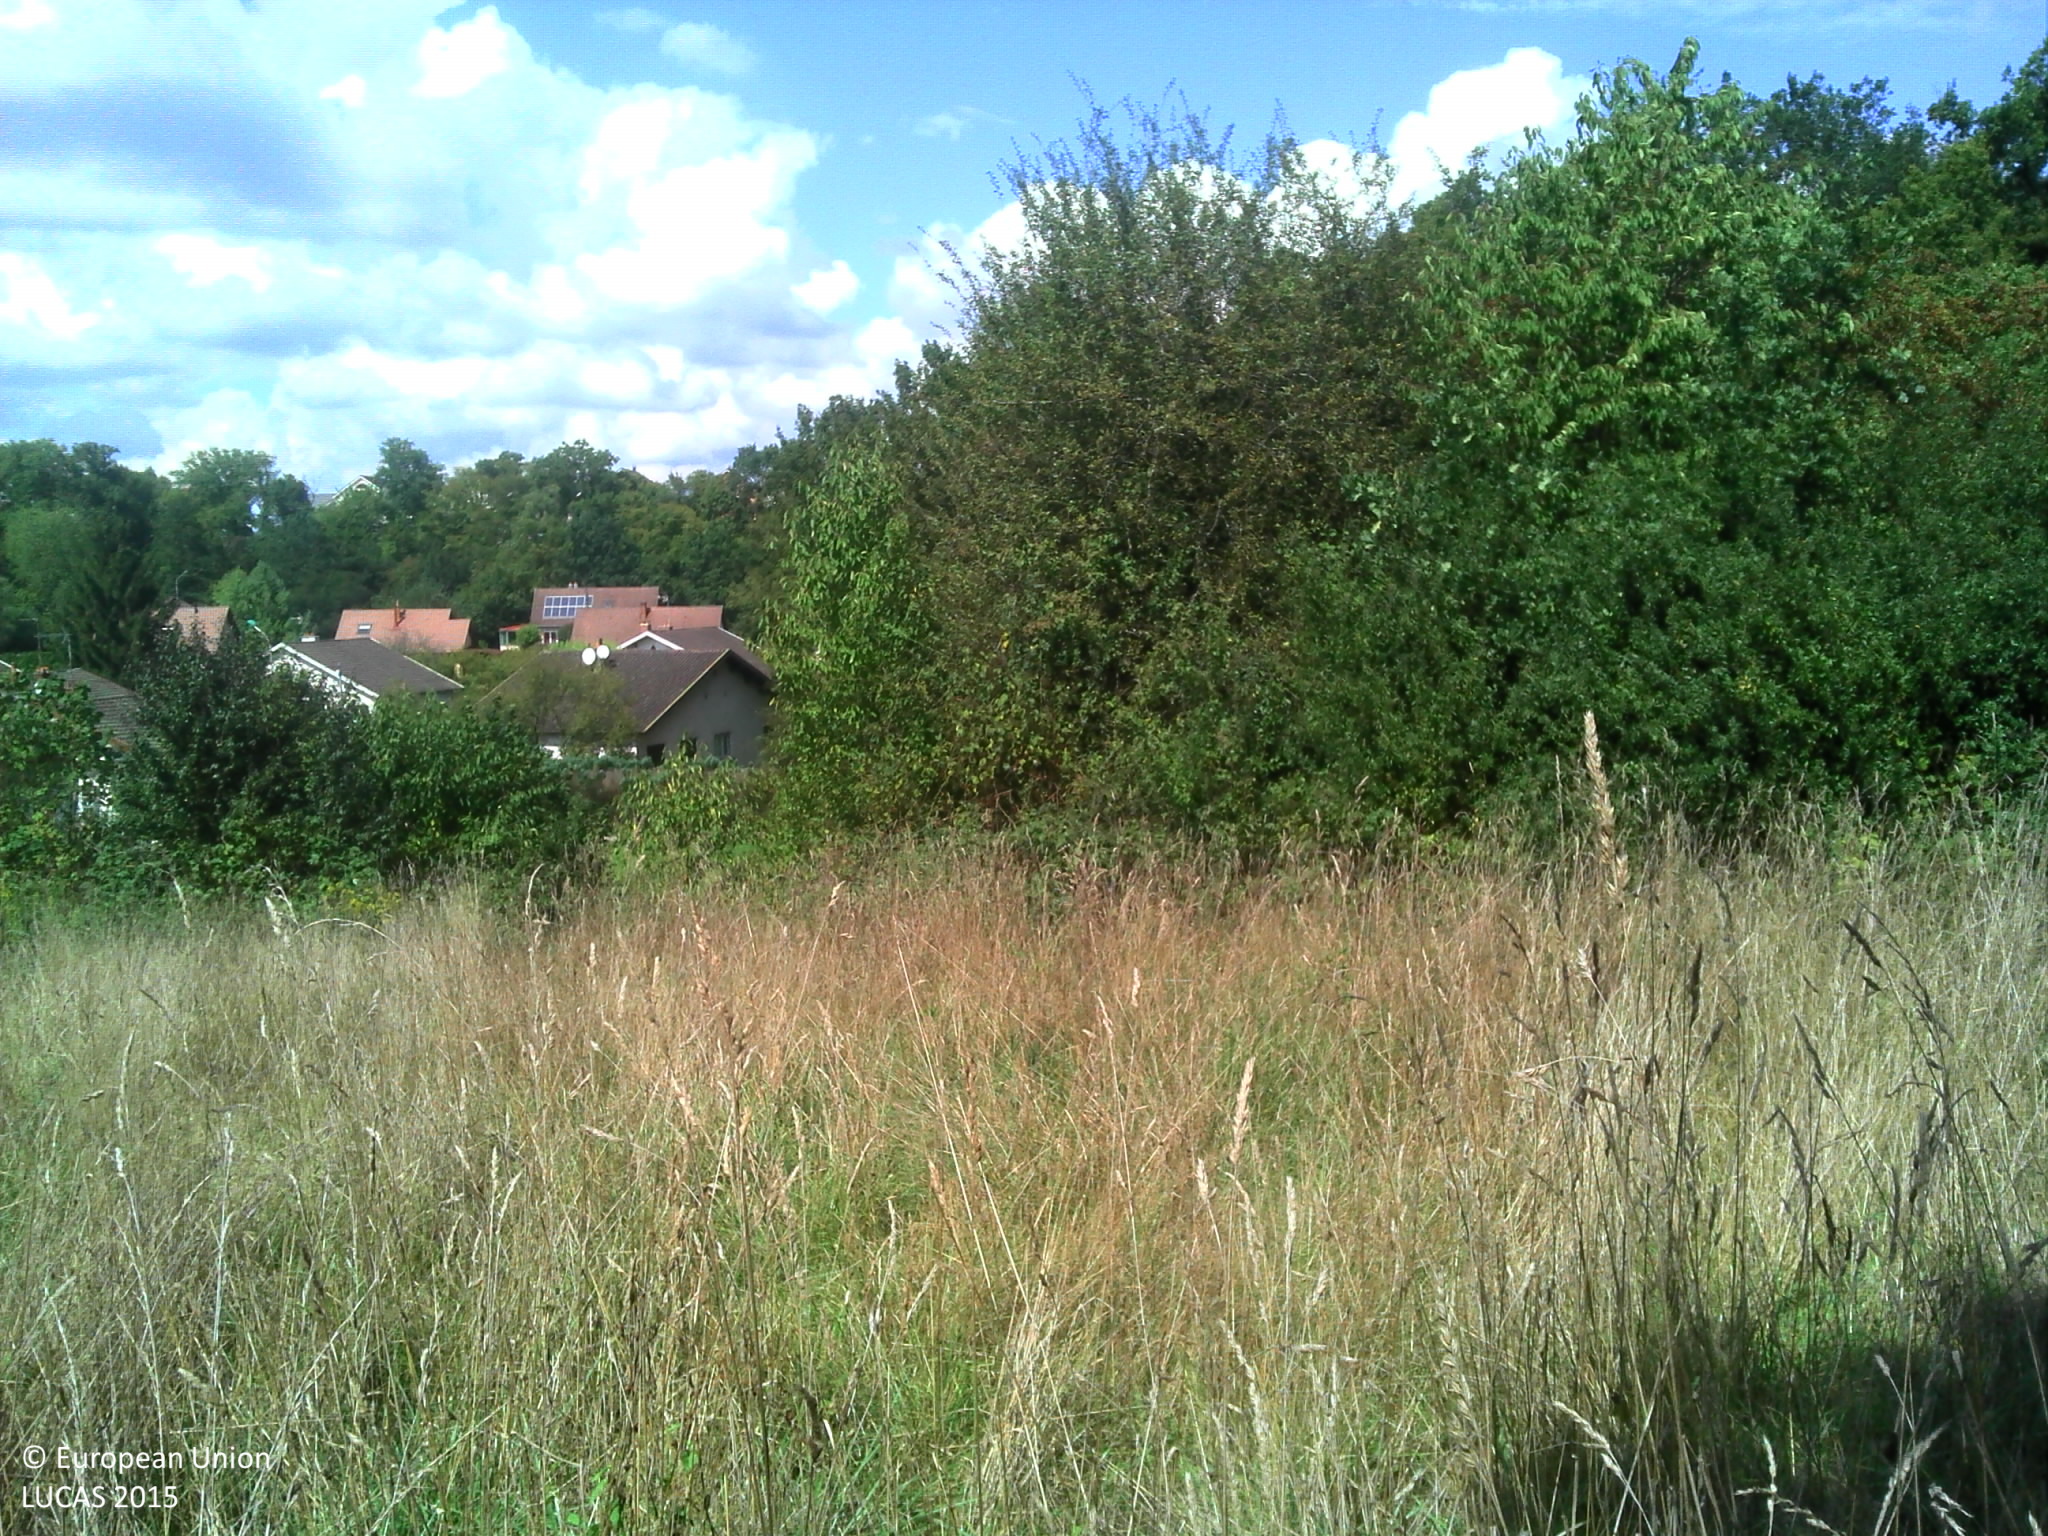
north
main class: Grassland
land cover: Grassland without tree/shrub cover
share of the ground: > 75 %
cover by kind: herbaceous plants 100 %
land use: Agriculture (excluding fallow land and kitchen gardens)
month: September
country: FR
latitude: 47.4763
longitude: 6.8569
